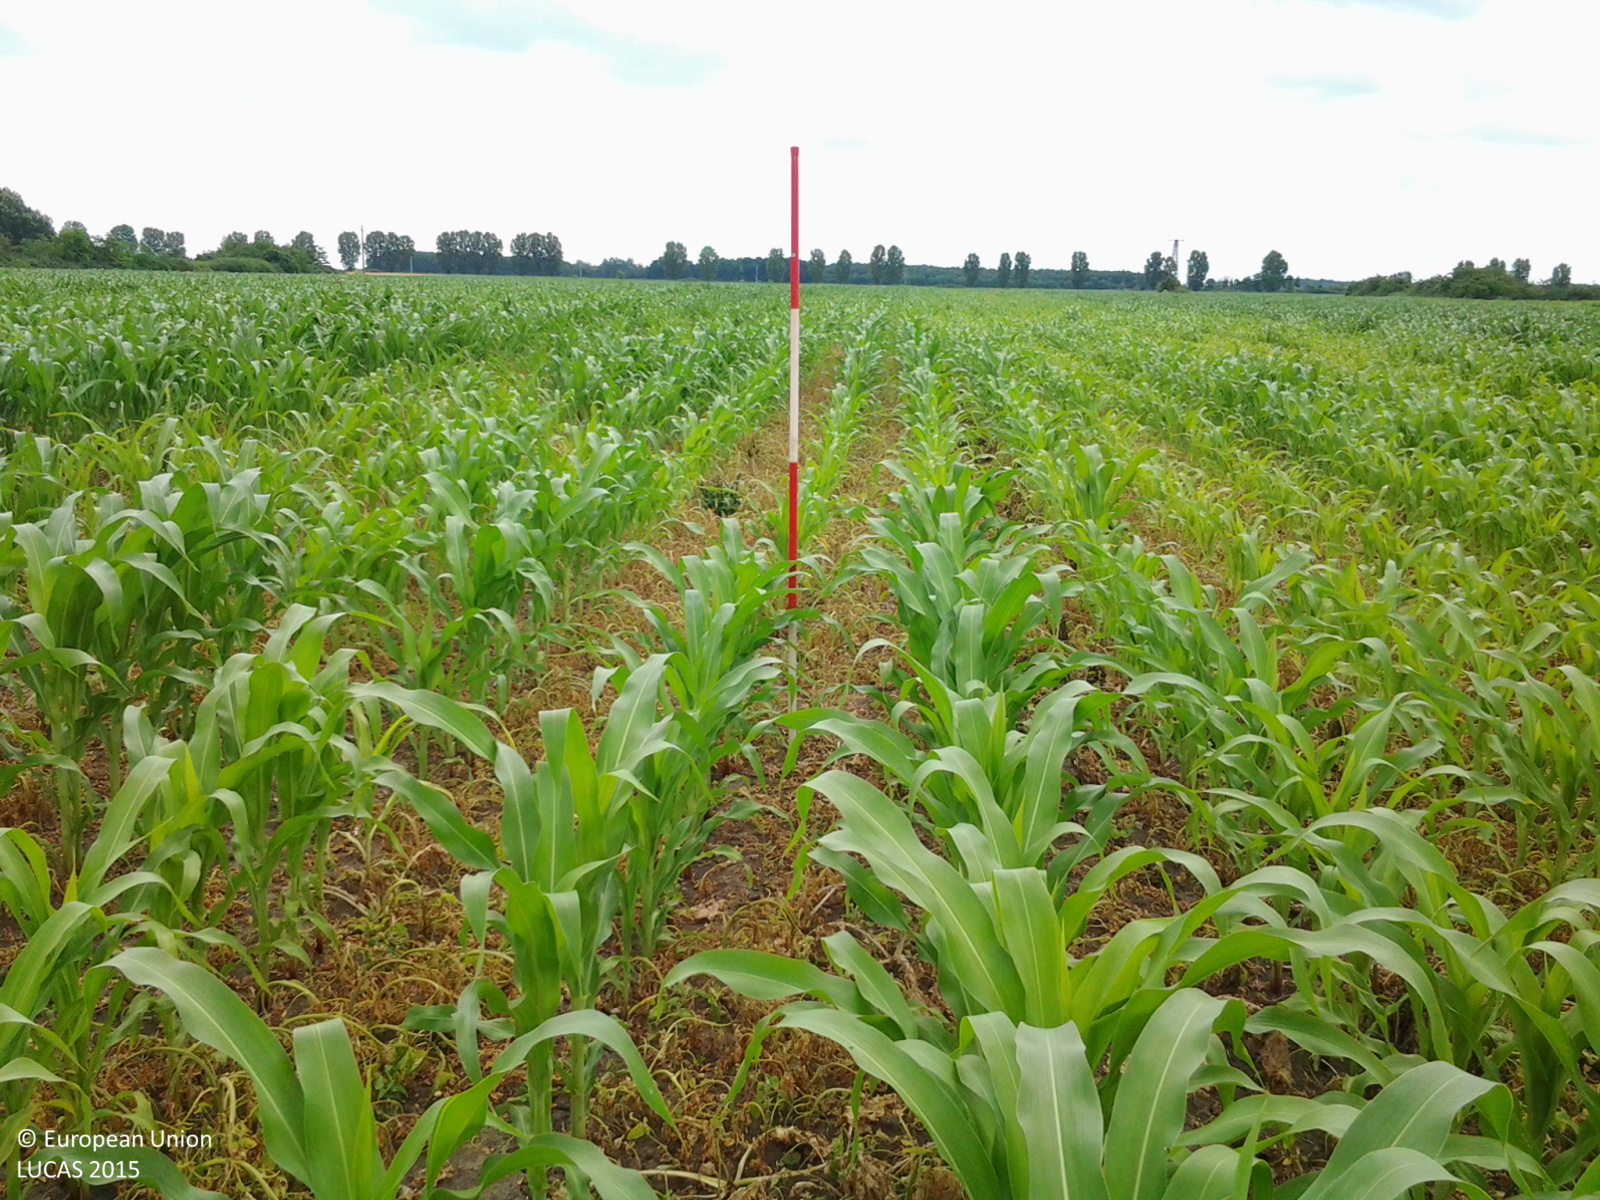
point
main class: Cropland
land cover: Maize
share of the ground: > 75 %
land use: Agriculture (excluding fallow land and kitchen gardens)
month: June
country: HU
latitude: 46.5620
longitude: 21.1879
